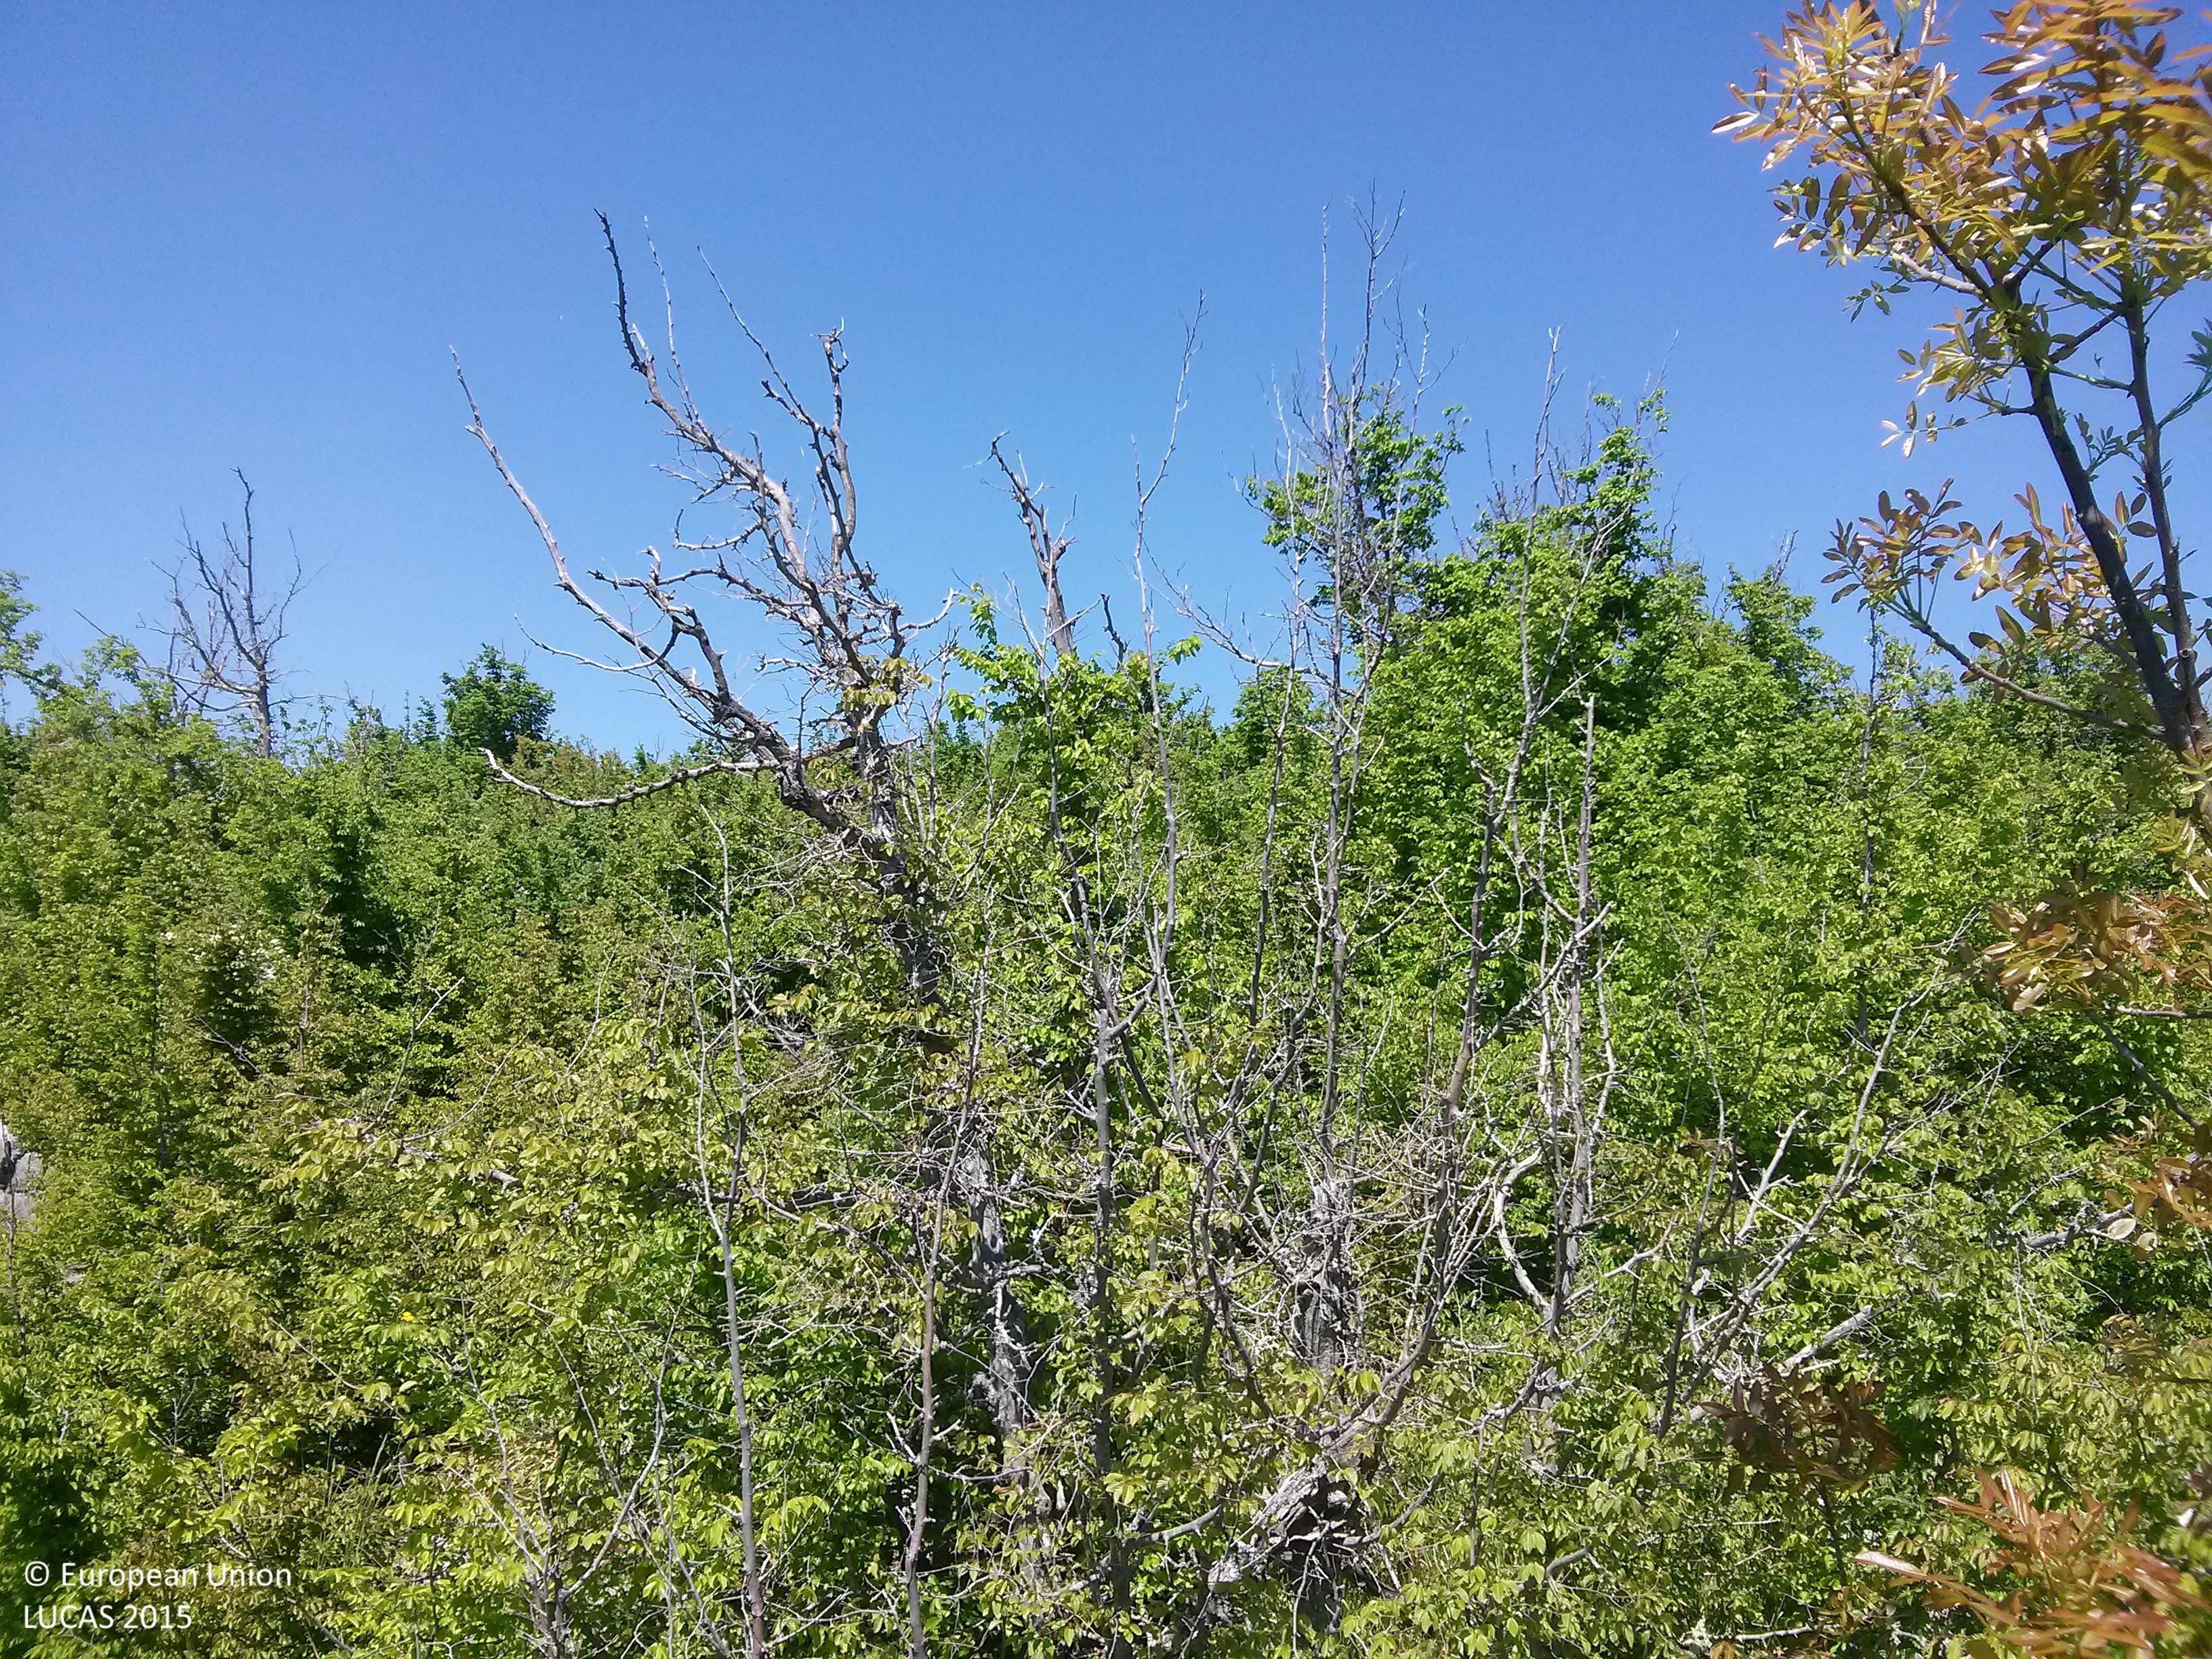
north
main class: Woodland
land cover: Broadleaved woodland
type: thermophilous deciduous forest
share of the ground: > 75 %
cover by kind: broadleaved forest trees 90 %, herbaceous plants 5 %, unconsolidated bare surface 5 %
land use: Semi-natural and natural areas not in use
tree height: < 5 m
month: April
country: HR
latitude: 44.1656
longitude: 15.8828
